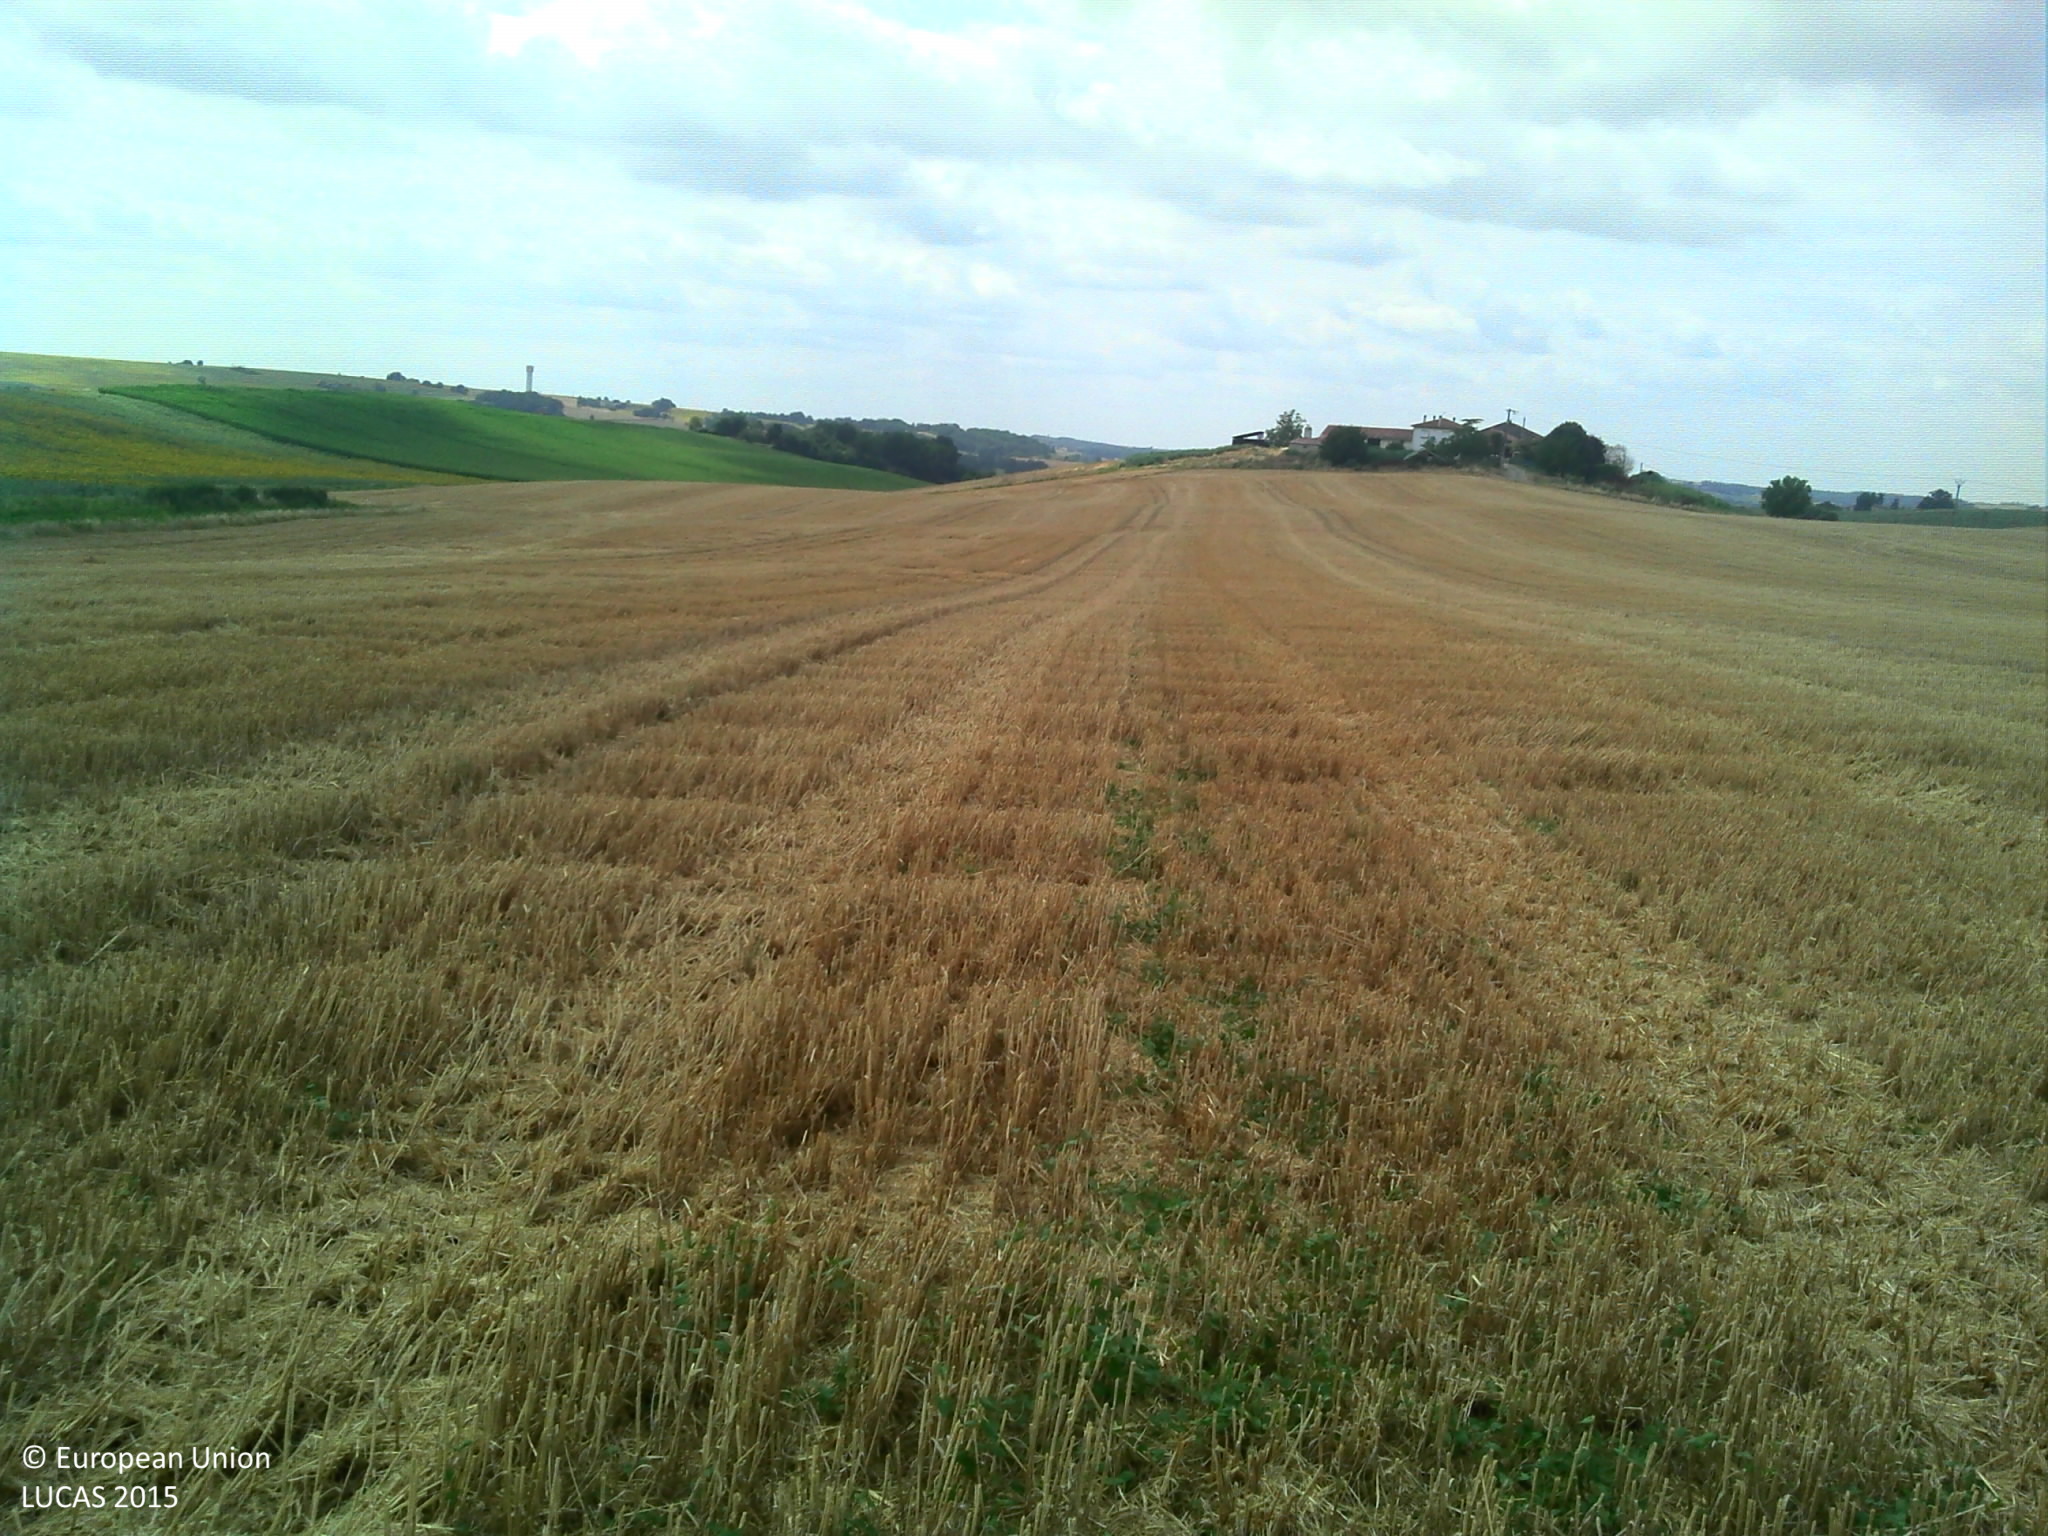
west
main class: Cropland
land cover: Barley
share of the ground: > 75 %
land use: Agriculture (excluding fallow land and kitchen gardens)
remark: Harvested field
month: July
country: FR
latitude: 43.8103
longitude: 0.9614
